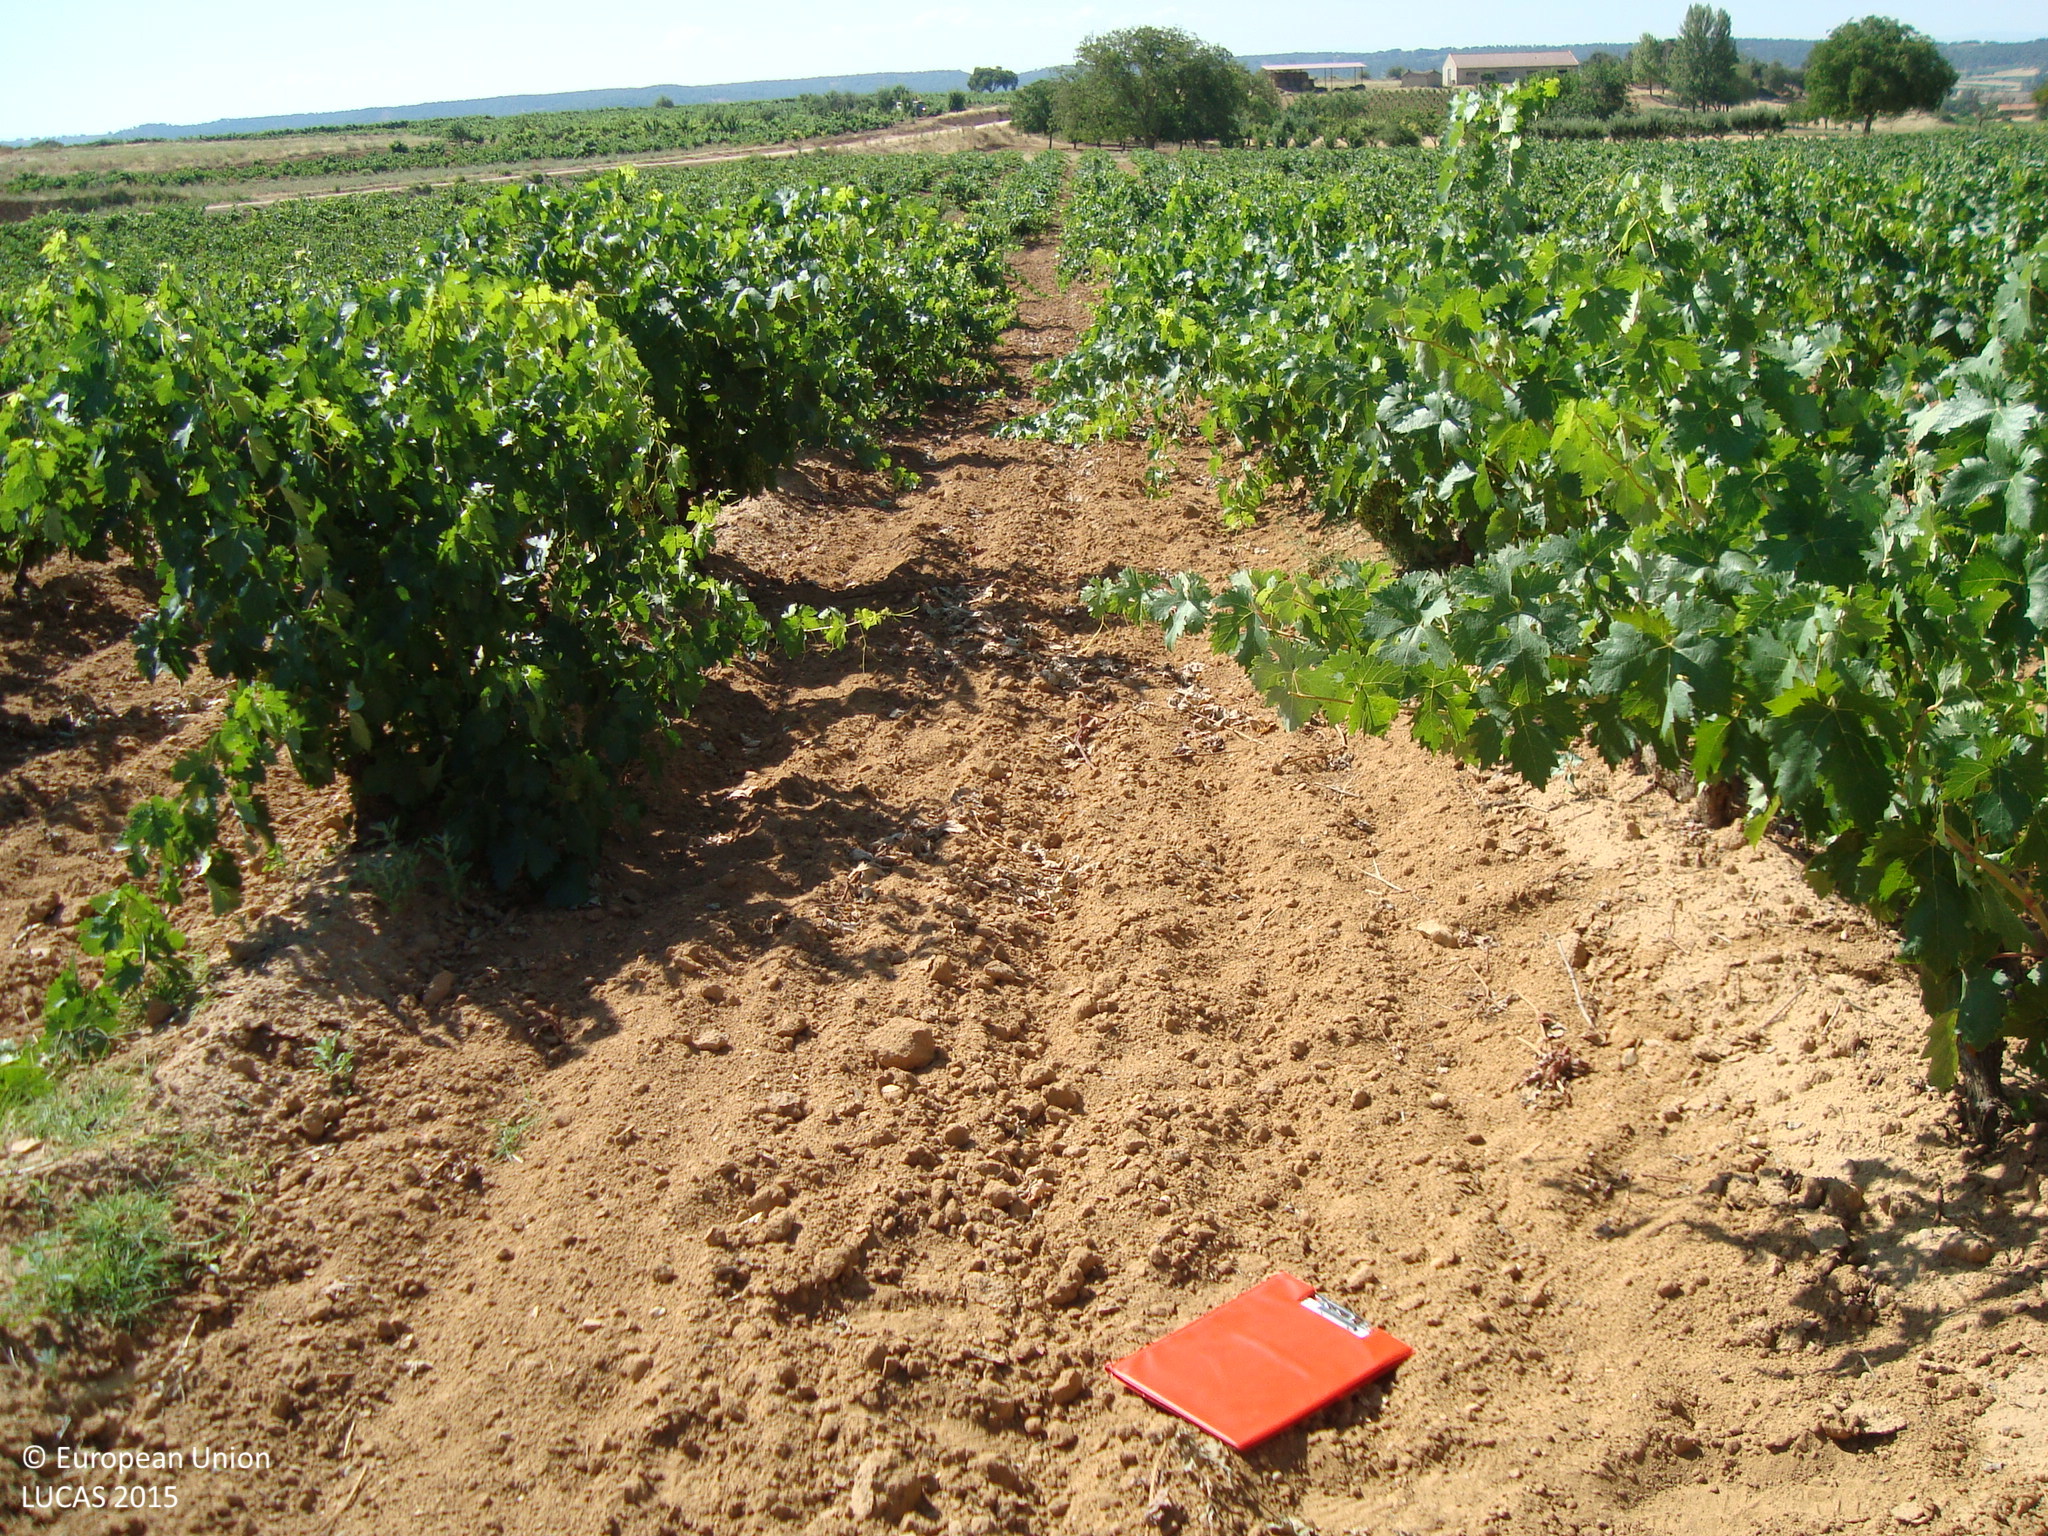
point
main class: Cropland
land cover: Vineyards
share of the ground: 25 - 50 %
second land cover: Other bare soil
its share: > 75 %
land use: Agriculture (excluding fallow land and kitchen gardens)
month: July
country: ES
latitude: 41.7654
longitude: -3.7555
